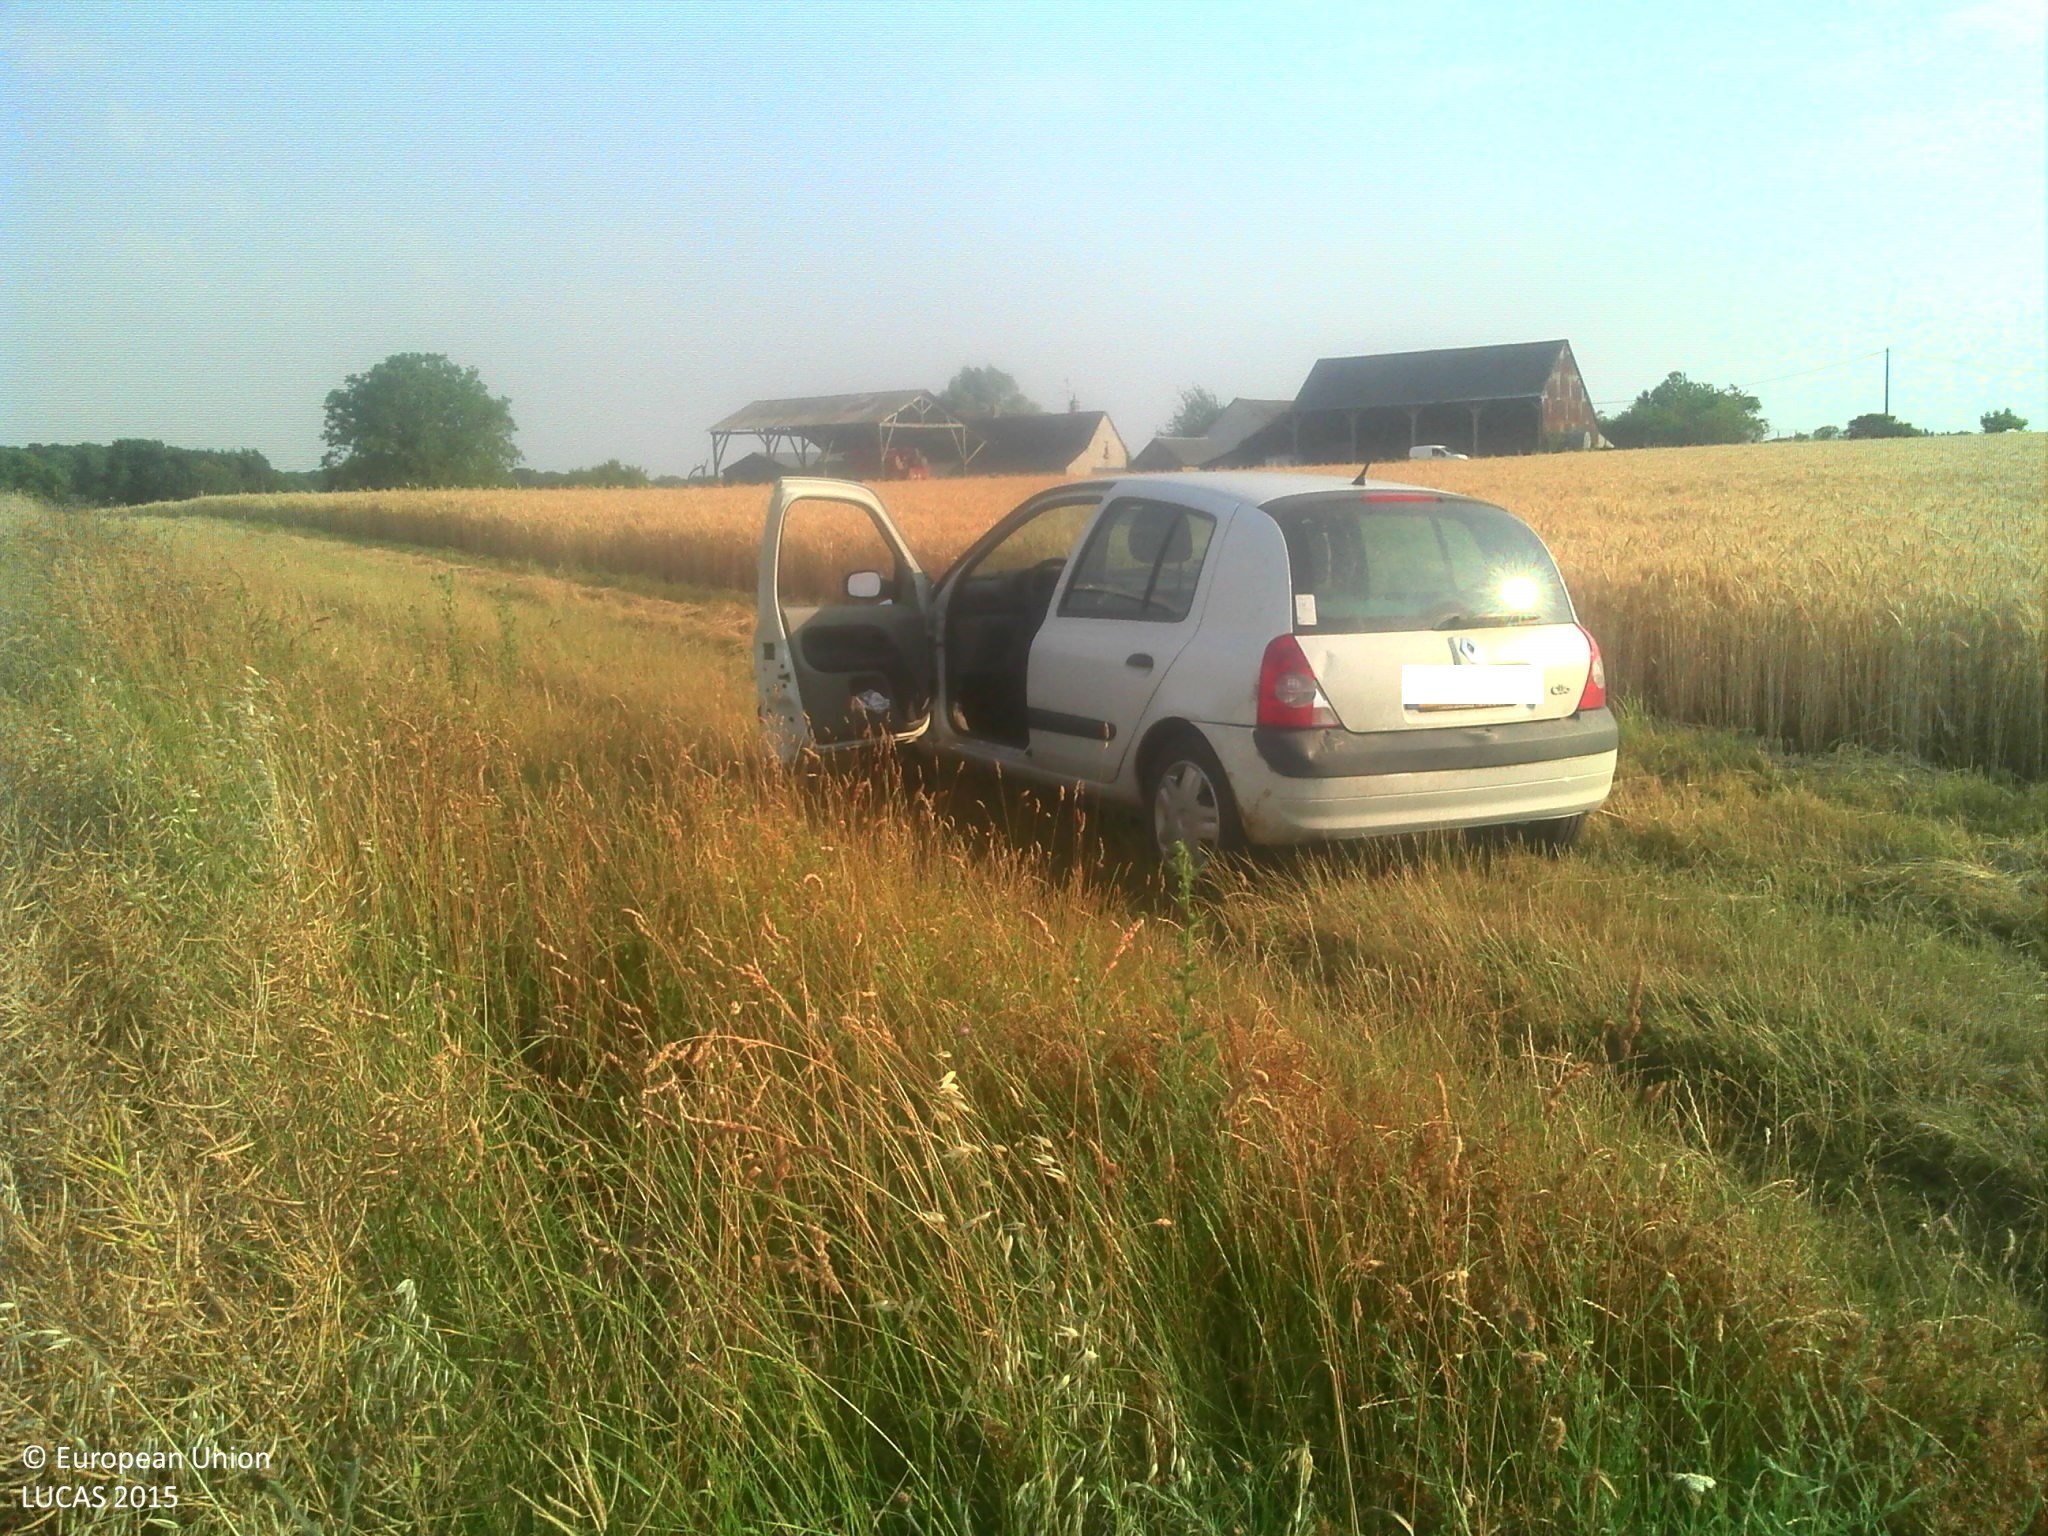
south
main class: Cropland
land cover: Rape and turnip rape
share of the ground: > 75 %
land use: Agriculture (excluding fallow land and kitchen gardens)
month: July
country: FR
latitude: 47.6482
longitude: 1.1301
